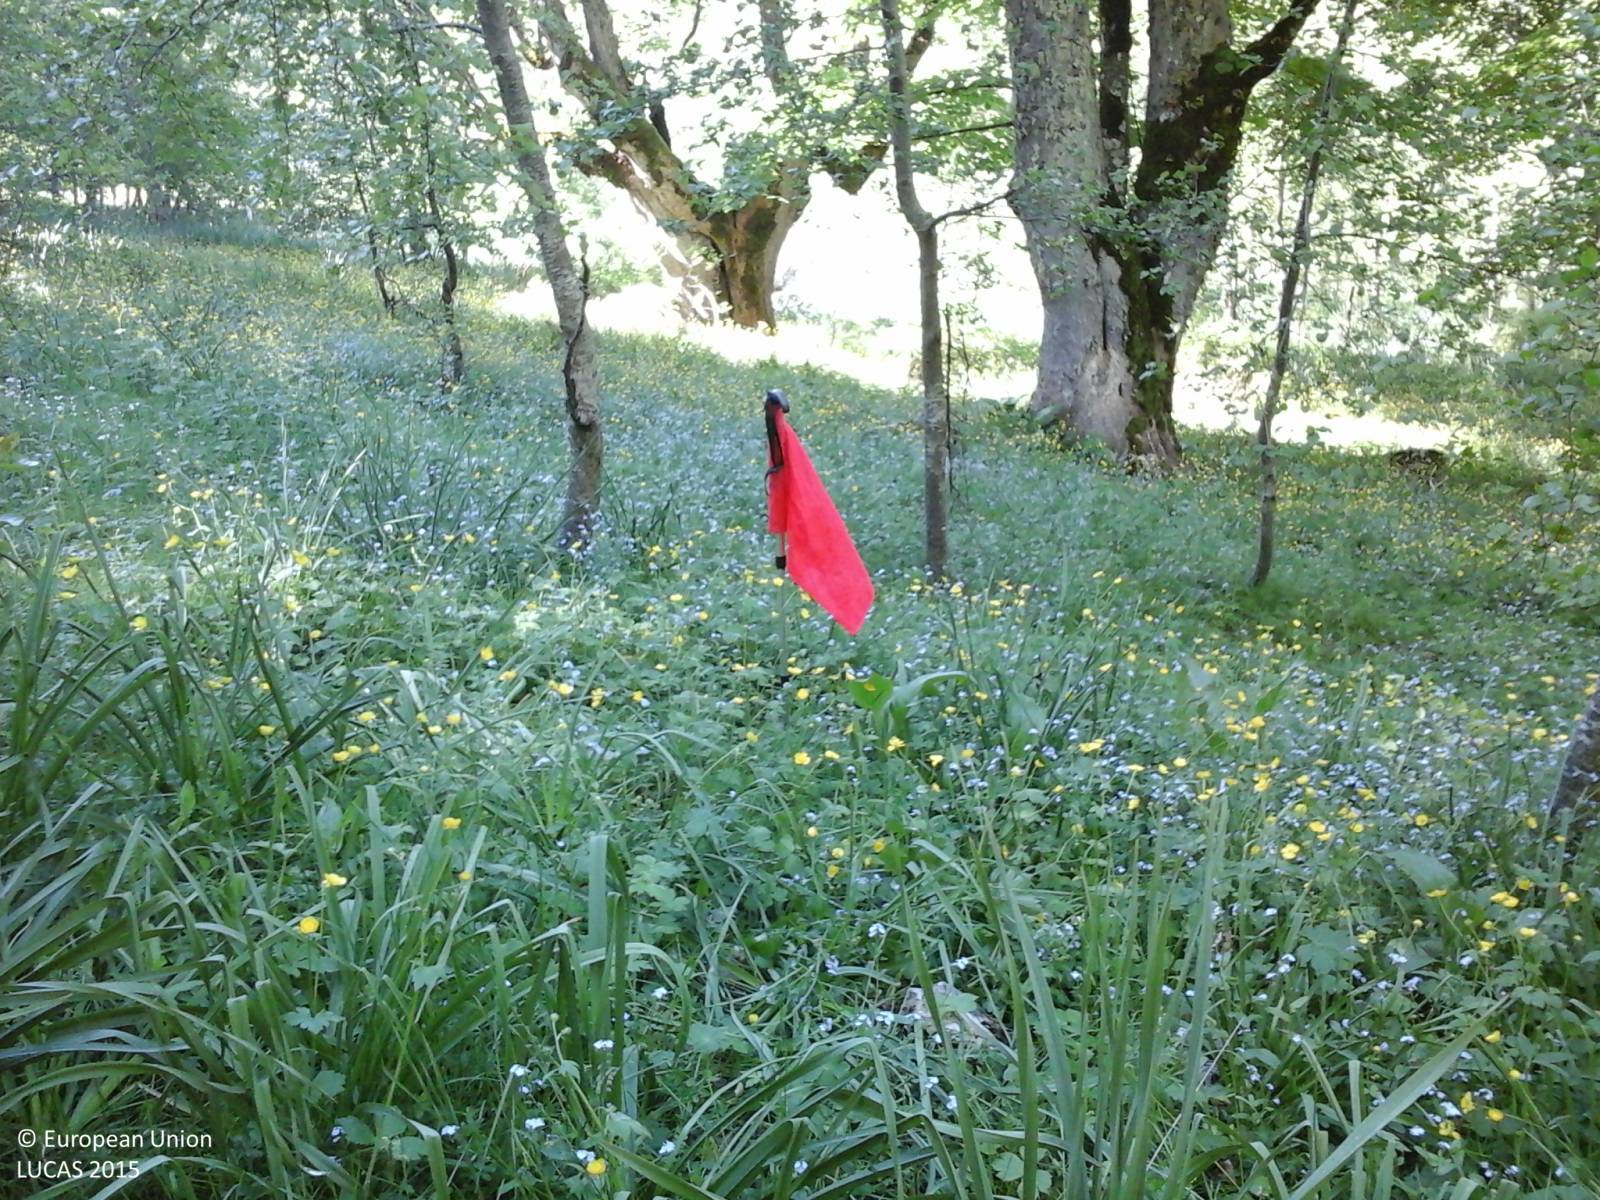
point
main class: Woodland
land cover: Broadleaved woodland
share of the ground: > 75 %
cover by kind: broadleaved forest trees 80 %, herbaceous plants 15 %, shrubs 5 %
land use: Semi-natural and natural areas not in use
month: May
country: IT
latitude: 42.0065
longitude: 13.2125
